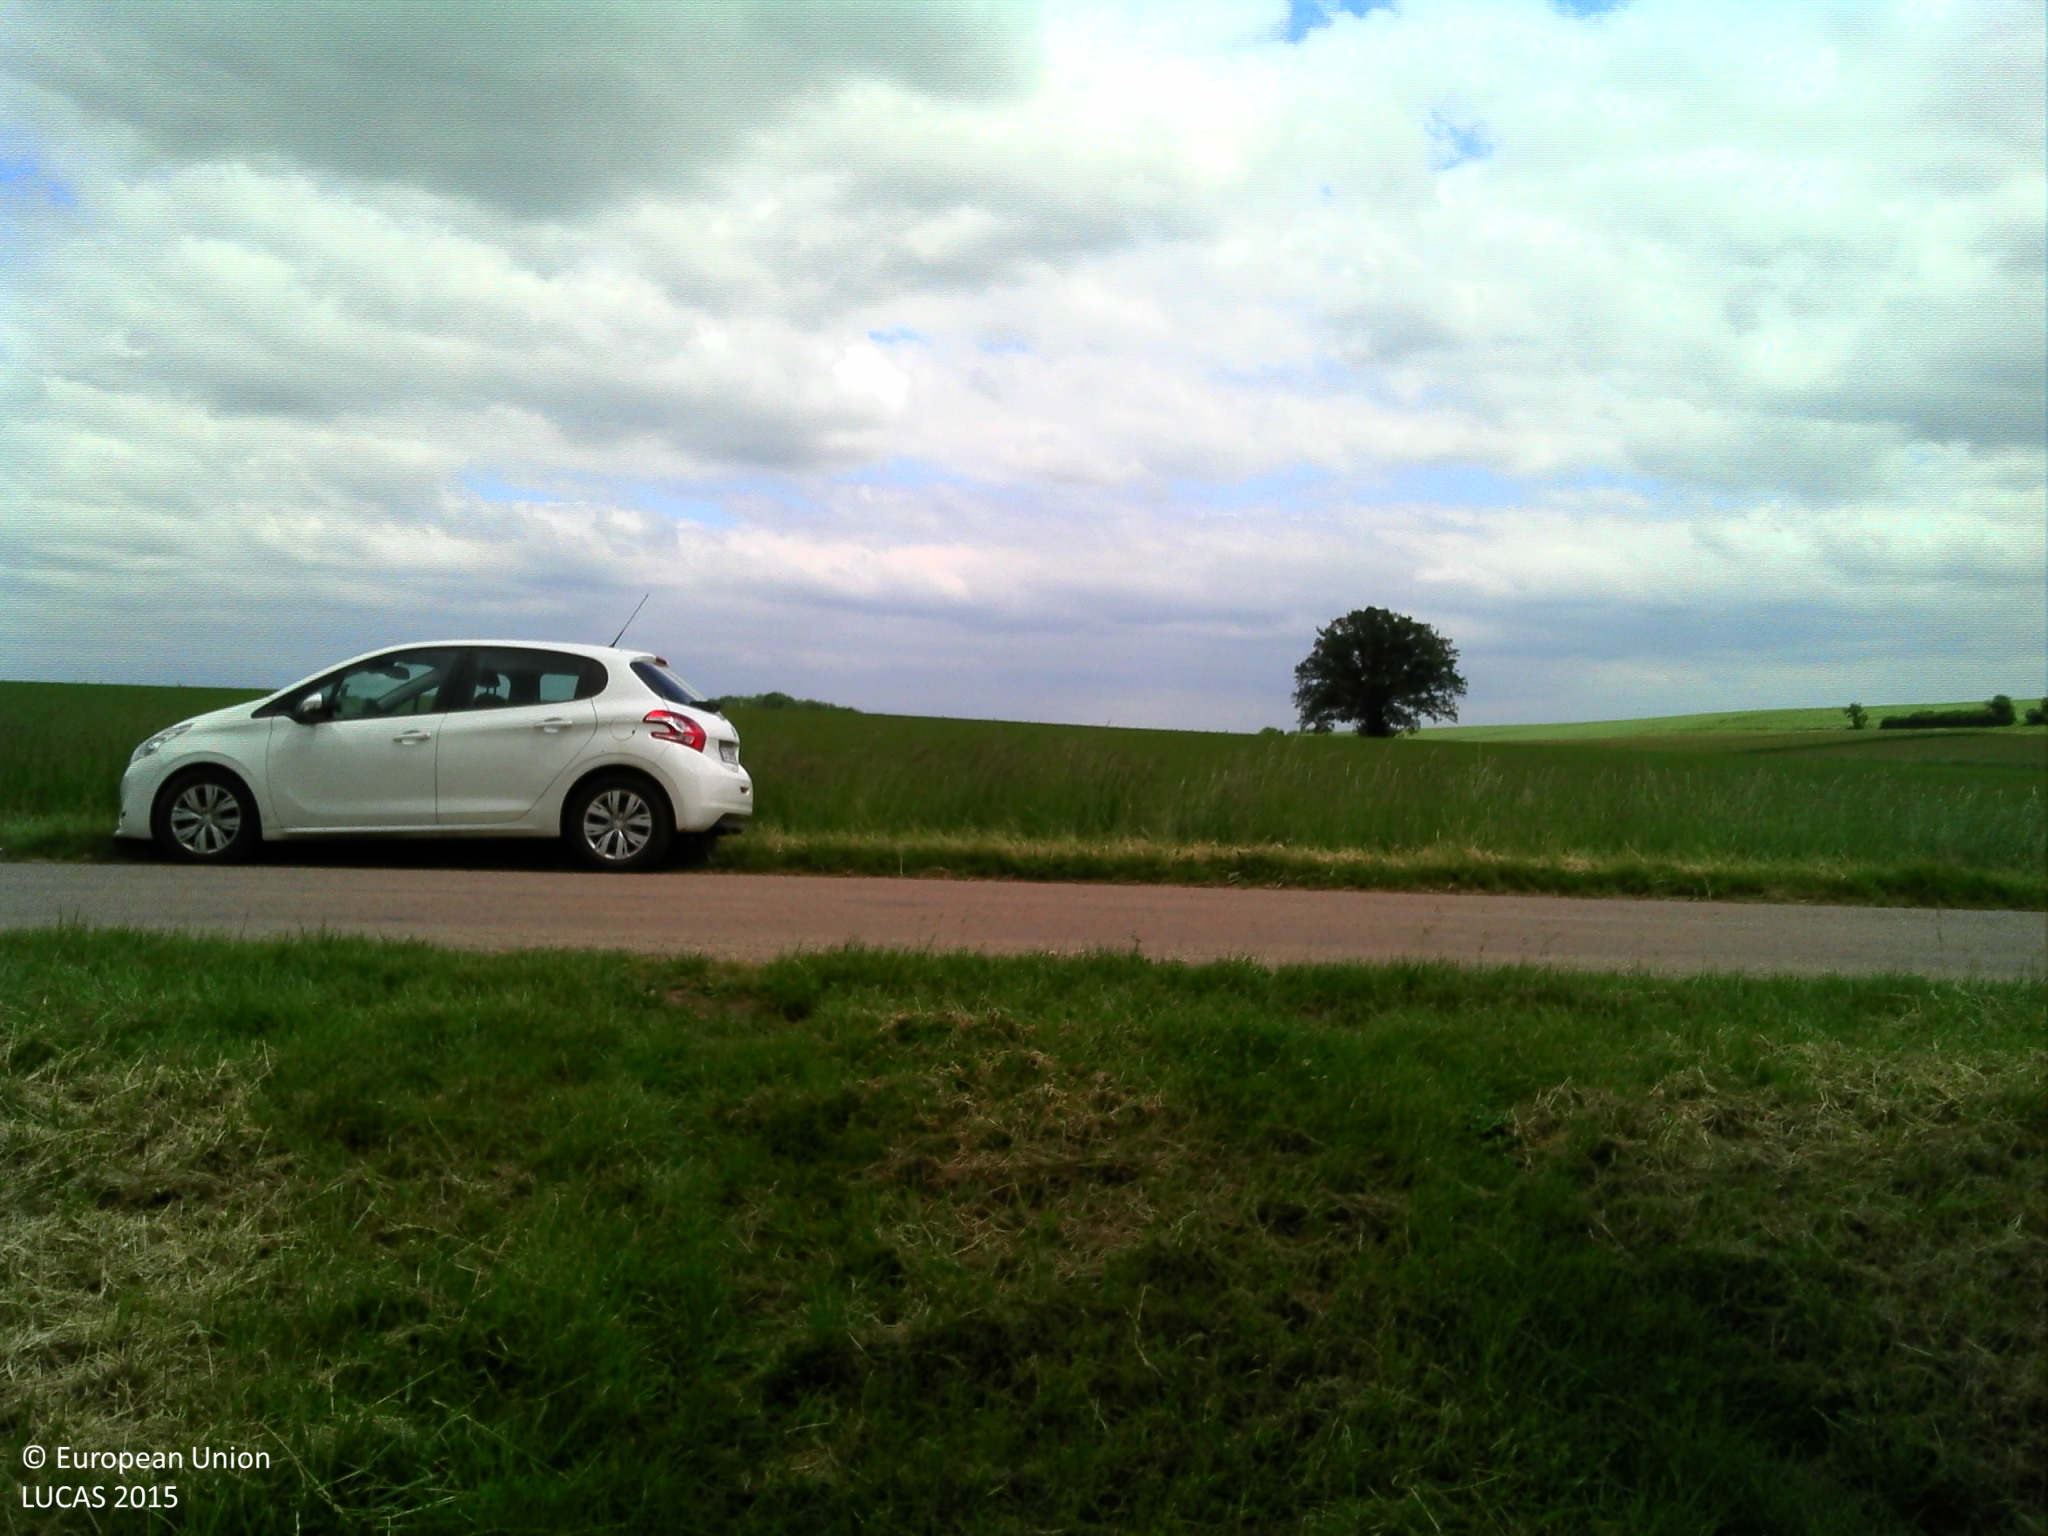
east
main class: Grassland
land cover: Grassland without tree/shrub cover
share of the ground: > 75 %
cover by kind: herbaceous plants 95 %, shrubs 5 %
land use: Agriculture (excluding fallow land and kitchen gardens)
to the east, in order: Grassland without tree/shrub cover; Lines of trees; Fences; Grassland without tree/shrub cover; Paved roads, cycling and walking lanes; Grassland without tree/shrub cover; Ditches and canals; Grass margins; Soya
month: May
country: FR
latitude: 47.4010
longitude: 5.2703
